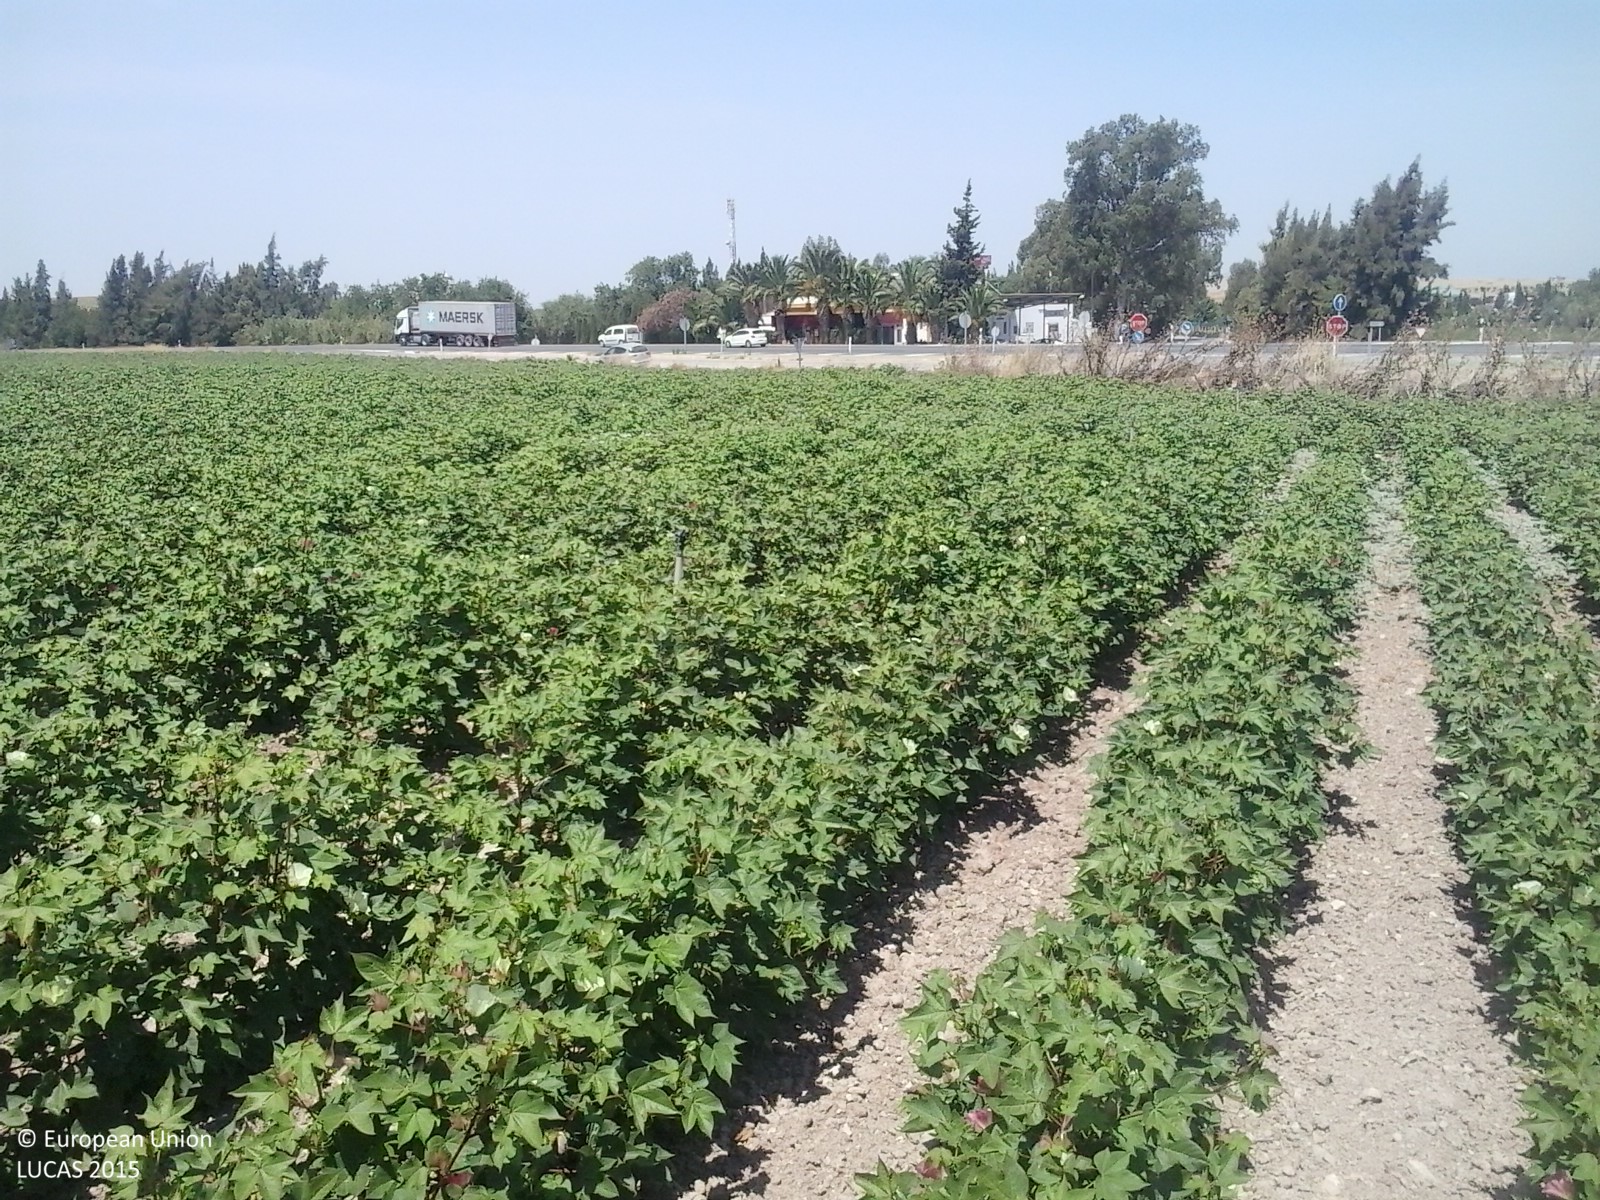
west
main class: Cropland
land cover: Cotton
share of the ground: 50 - 75 %
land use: Agriculture (excluding fallow land and kitchen gardens)
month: July
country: ES
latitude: 36.9024
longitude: -5.9840
